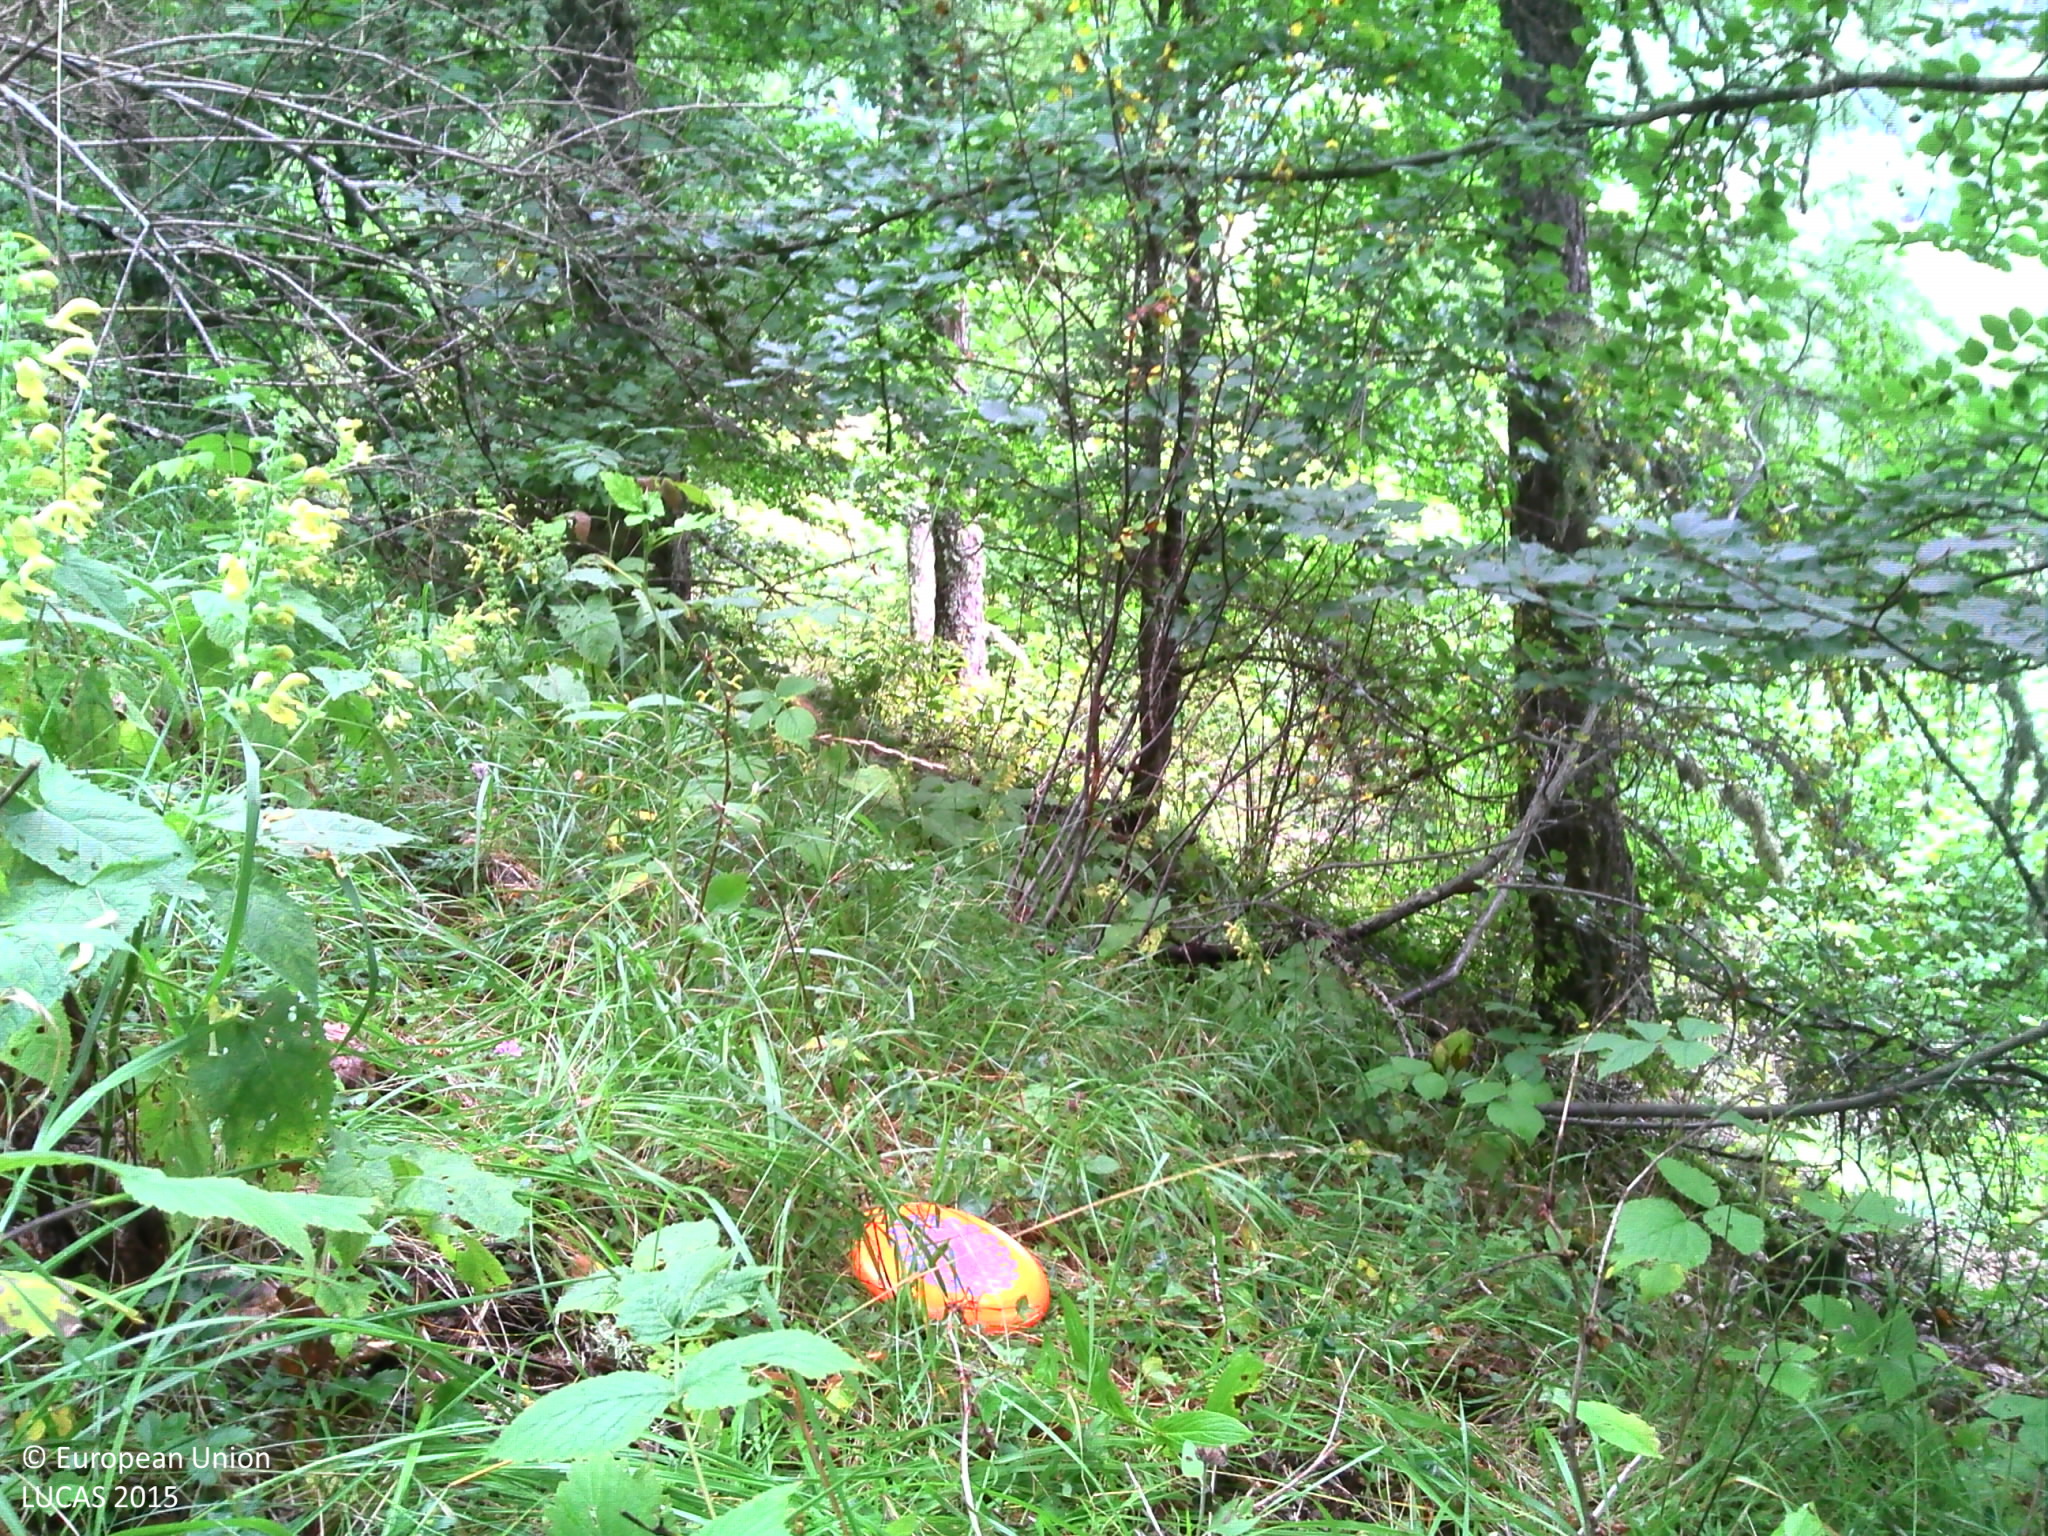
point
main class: Woodland
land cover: Pine dominated mixed woodland
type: alpine coniferous forest
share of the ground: > 75 %
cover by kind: coniferous forest trees 60 %, broadleaved forest trees 25 %, herbaceous plants 10 %, shrubs 5 %
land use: Forestry
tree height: > 5 m
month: September
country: FR
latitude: 44.7163
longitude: 6.2569
